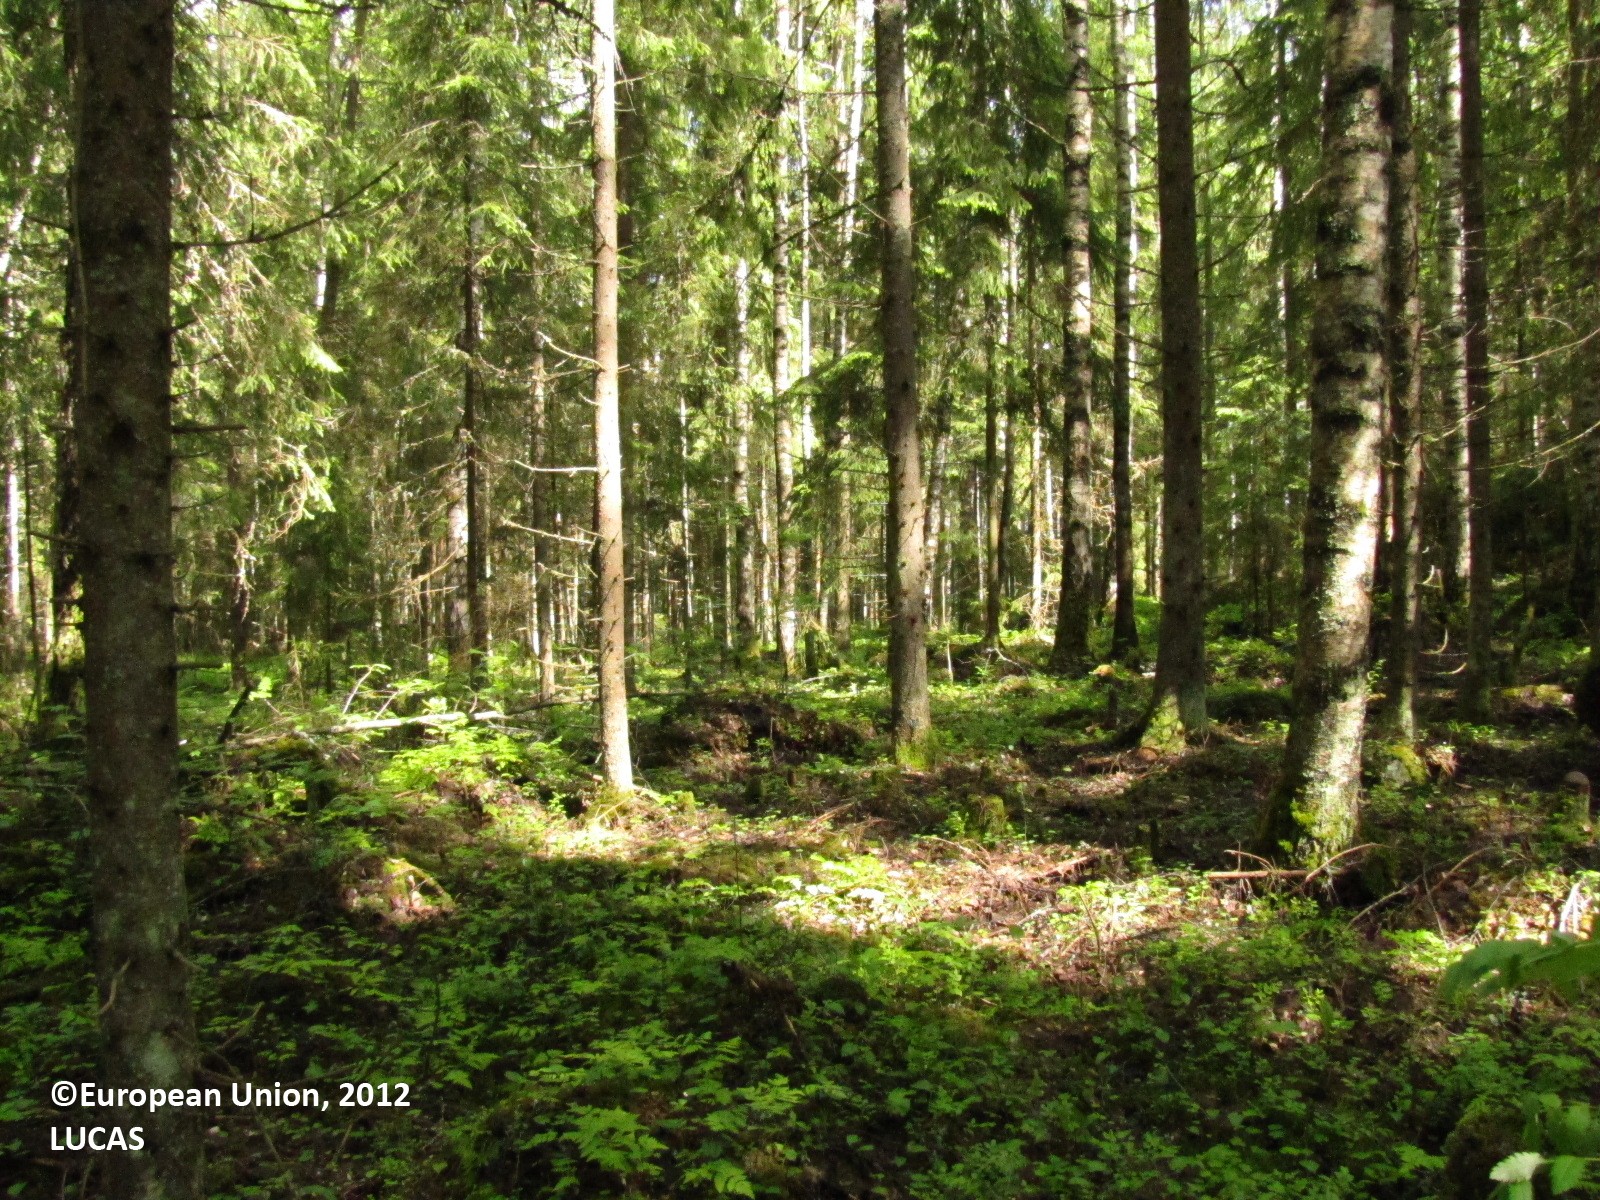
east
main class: Woodland
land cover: Spruce dominated mixed woodland
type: hemiboreal forest and nemoral coniferous forest and mixed broadleaved-coniferous forest
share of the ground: > 75 %
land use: Forestry
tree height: > 5 m
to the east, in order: Spruce dominated mixed woodland; Ditches and canals; Temporary grasslands; Abandoned hedges; Ditches and canals; Abandoned hedges; Pine dominated coniferous woodland
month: June
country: FI
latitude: 61.5802
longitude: 23.0869
